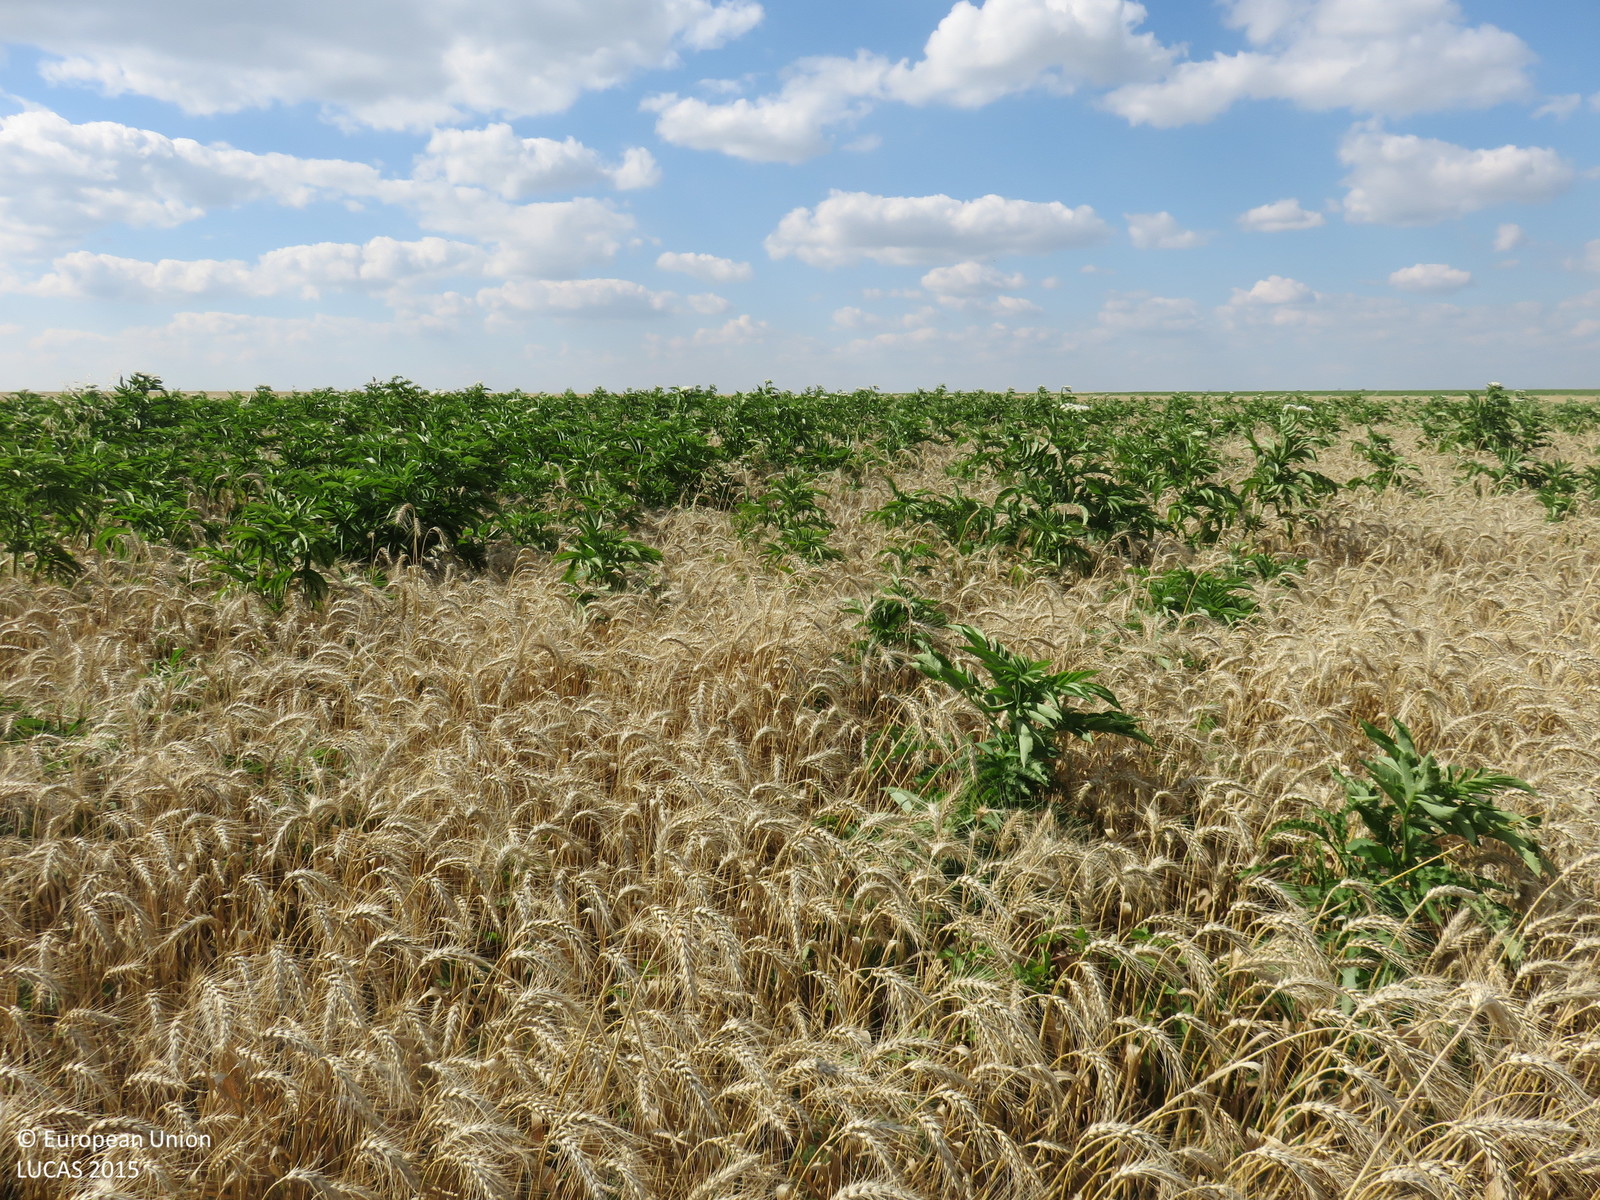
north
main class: Cropland
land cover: Common wheat
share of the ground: > 75 %
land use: Agriculture (excluding fallow land and kitchen gardens)
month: June
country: BG
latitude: 43.2763
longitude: 24.9656
